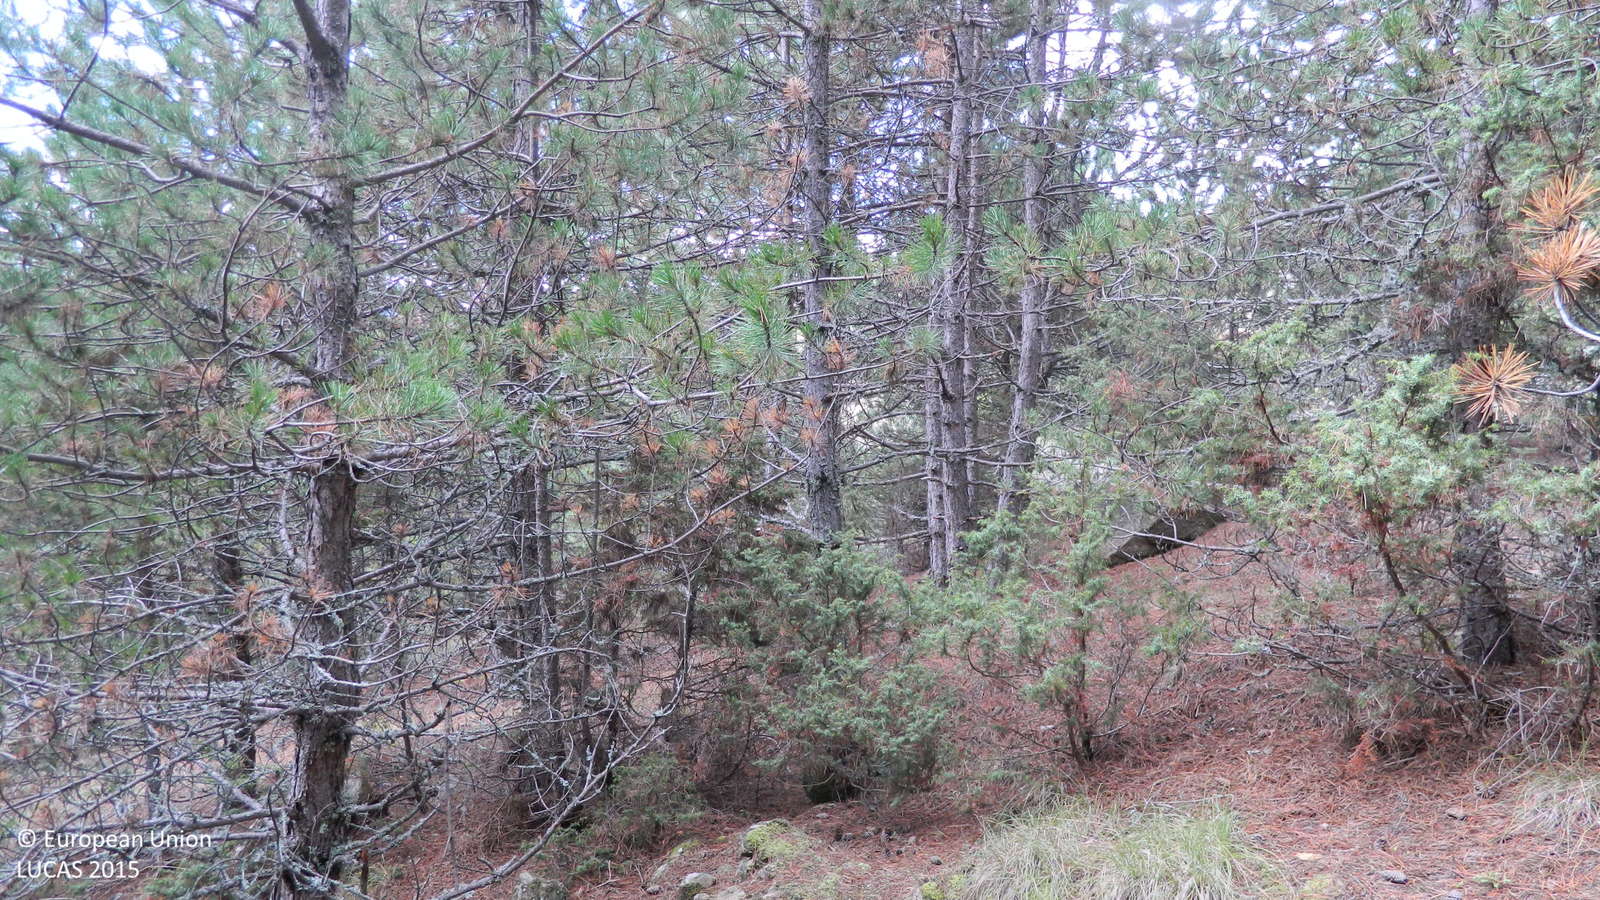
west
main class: Woodland
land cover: Pine dominated coniferous woodland
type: hemiboreal forest and nemoral coniferous forest and mixed broadleaved-coniferous forest
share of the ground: > 75 %
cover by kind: coniferous forest trees 80 %, herbaceous plants 10 %, unconsolidated bare surface 10 %
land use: Forestry
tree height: > 5 m
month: September
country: BG
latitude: 41.5239
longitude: 24.0415
